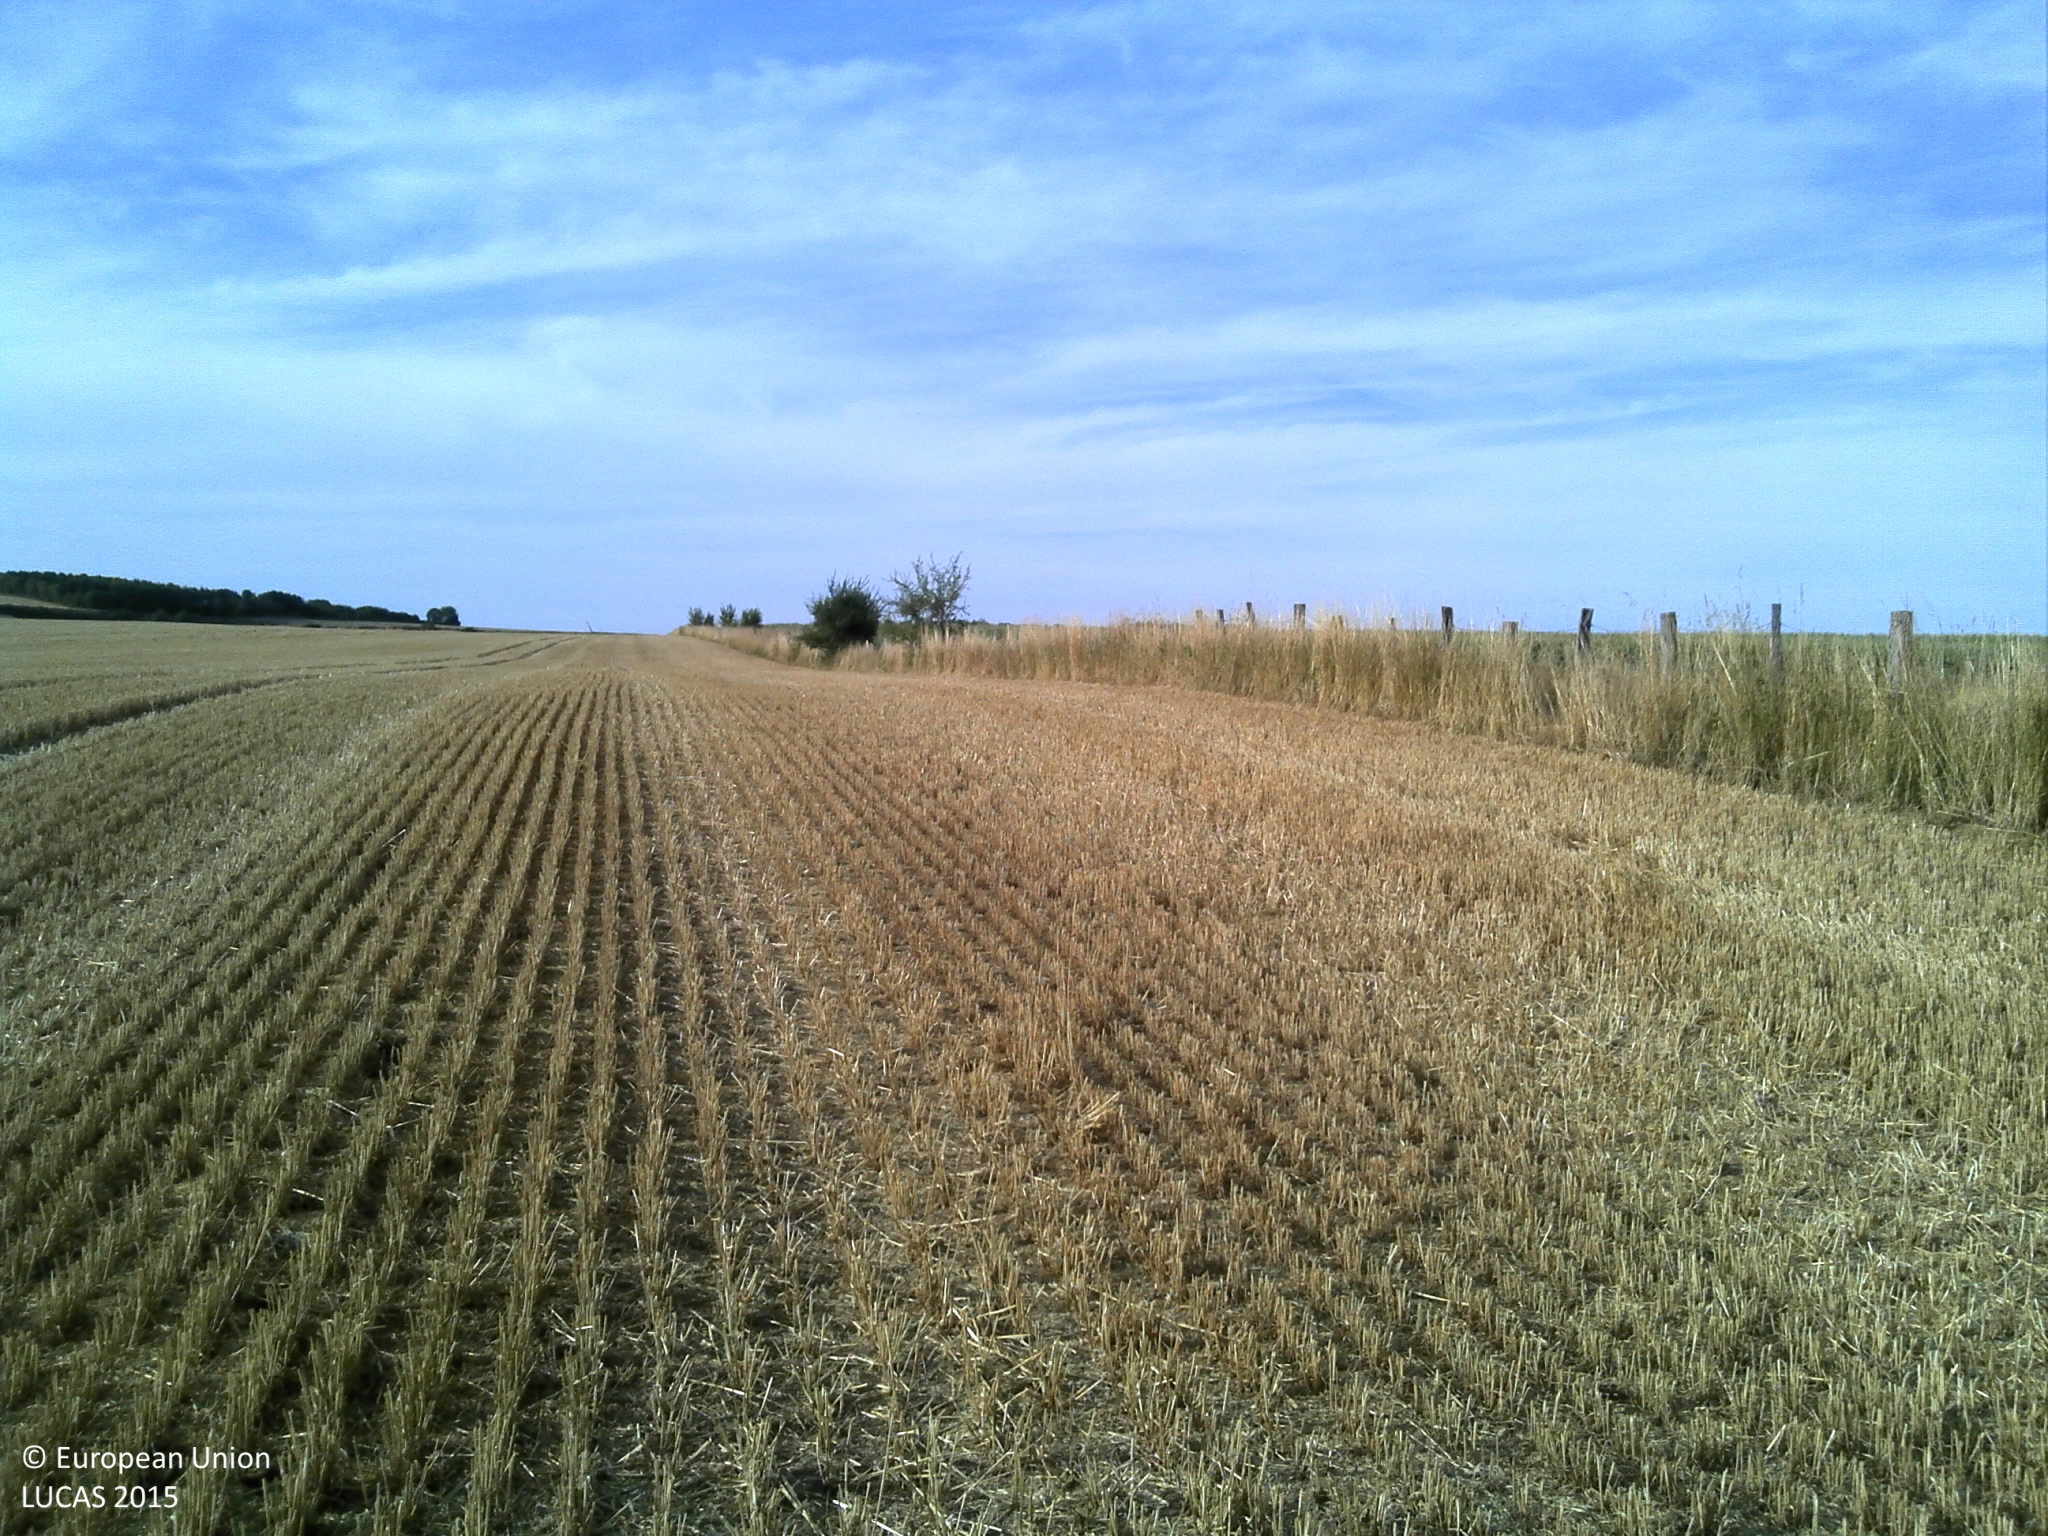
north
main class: Cropland
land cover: Common wheat
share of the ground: > 75 %
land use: Agriculture (excluding fallow land and kitchen gardens)
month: August
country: FR
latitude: 48.9493
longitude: 4.8223
